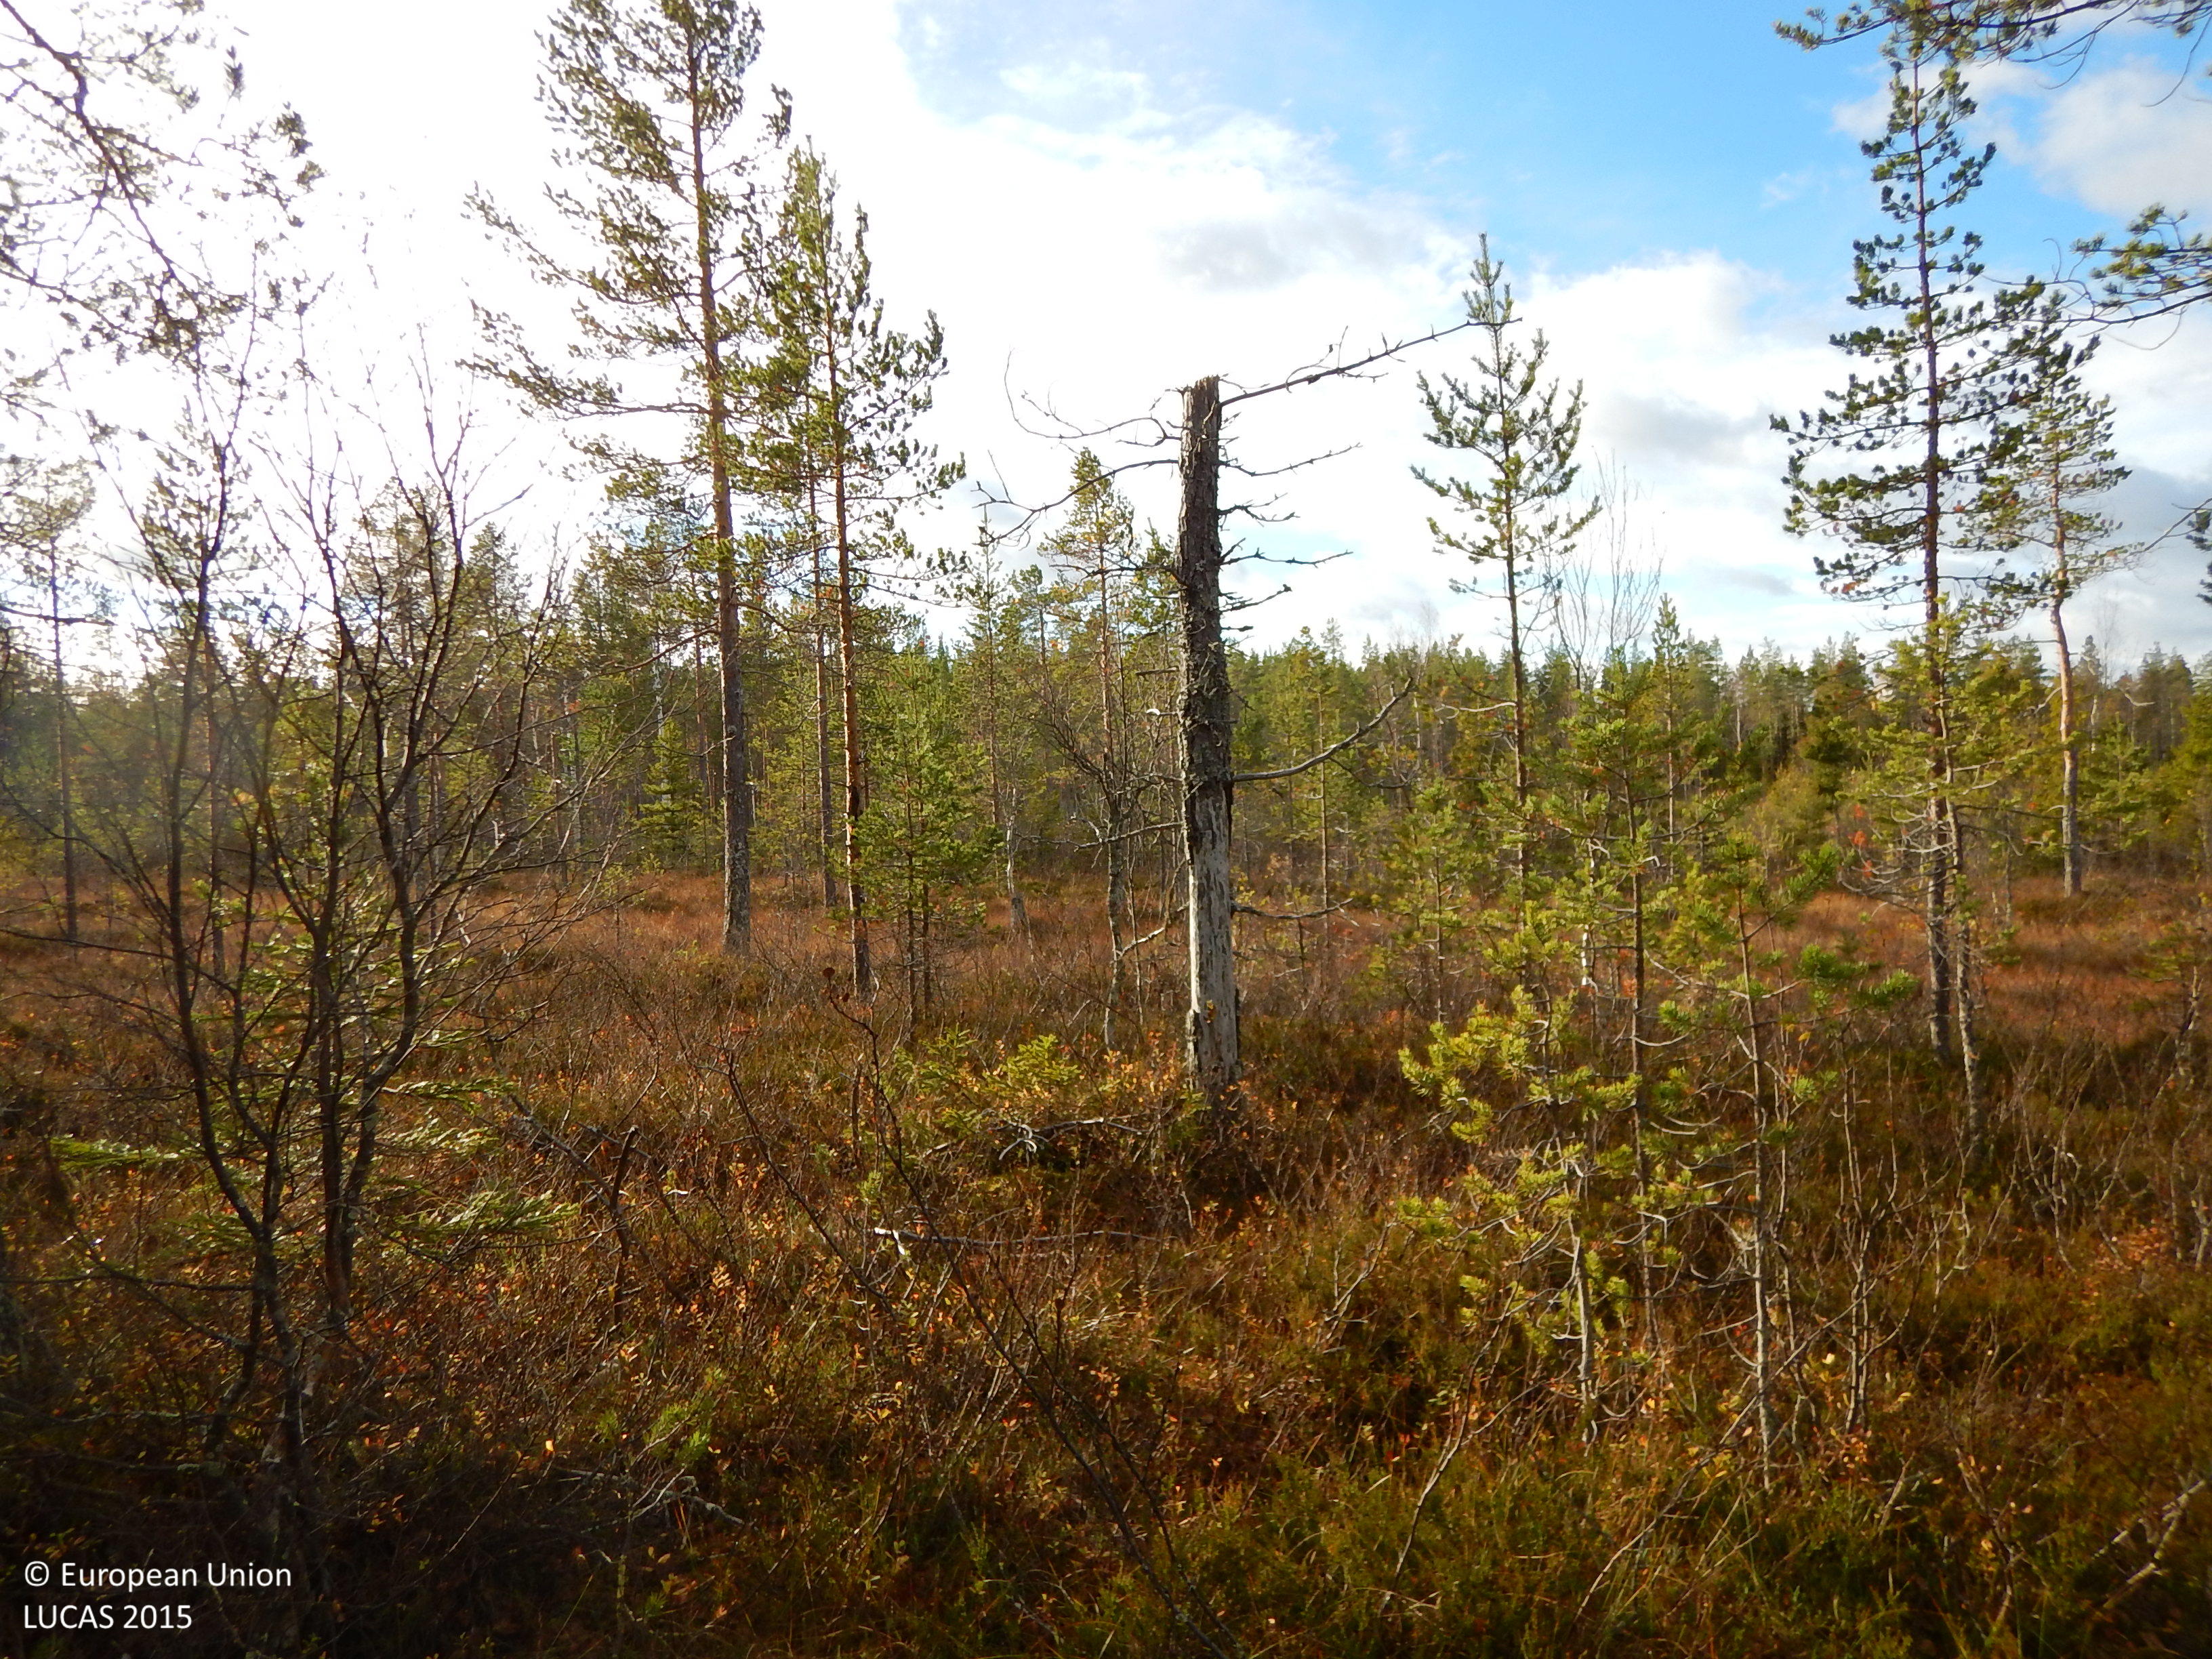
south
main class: Woodland
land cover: Pine dominated coniferous woodland
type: mire and swamp forests
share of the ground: 25 - 50 %
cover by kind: coniferous forest trees 40 %, lichens and mosses 25 %, shrubs 20 %, herbaceous plants 10 %, broadleaved forest trees 5 %
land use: Forestry
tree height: > 5 m
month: October
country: SE
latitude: 65.0169
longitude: 20.7749
